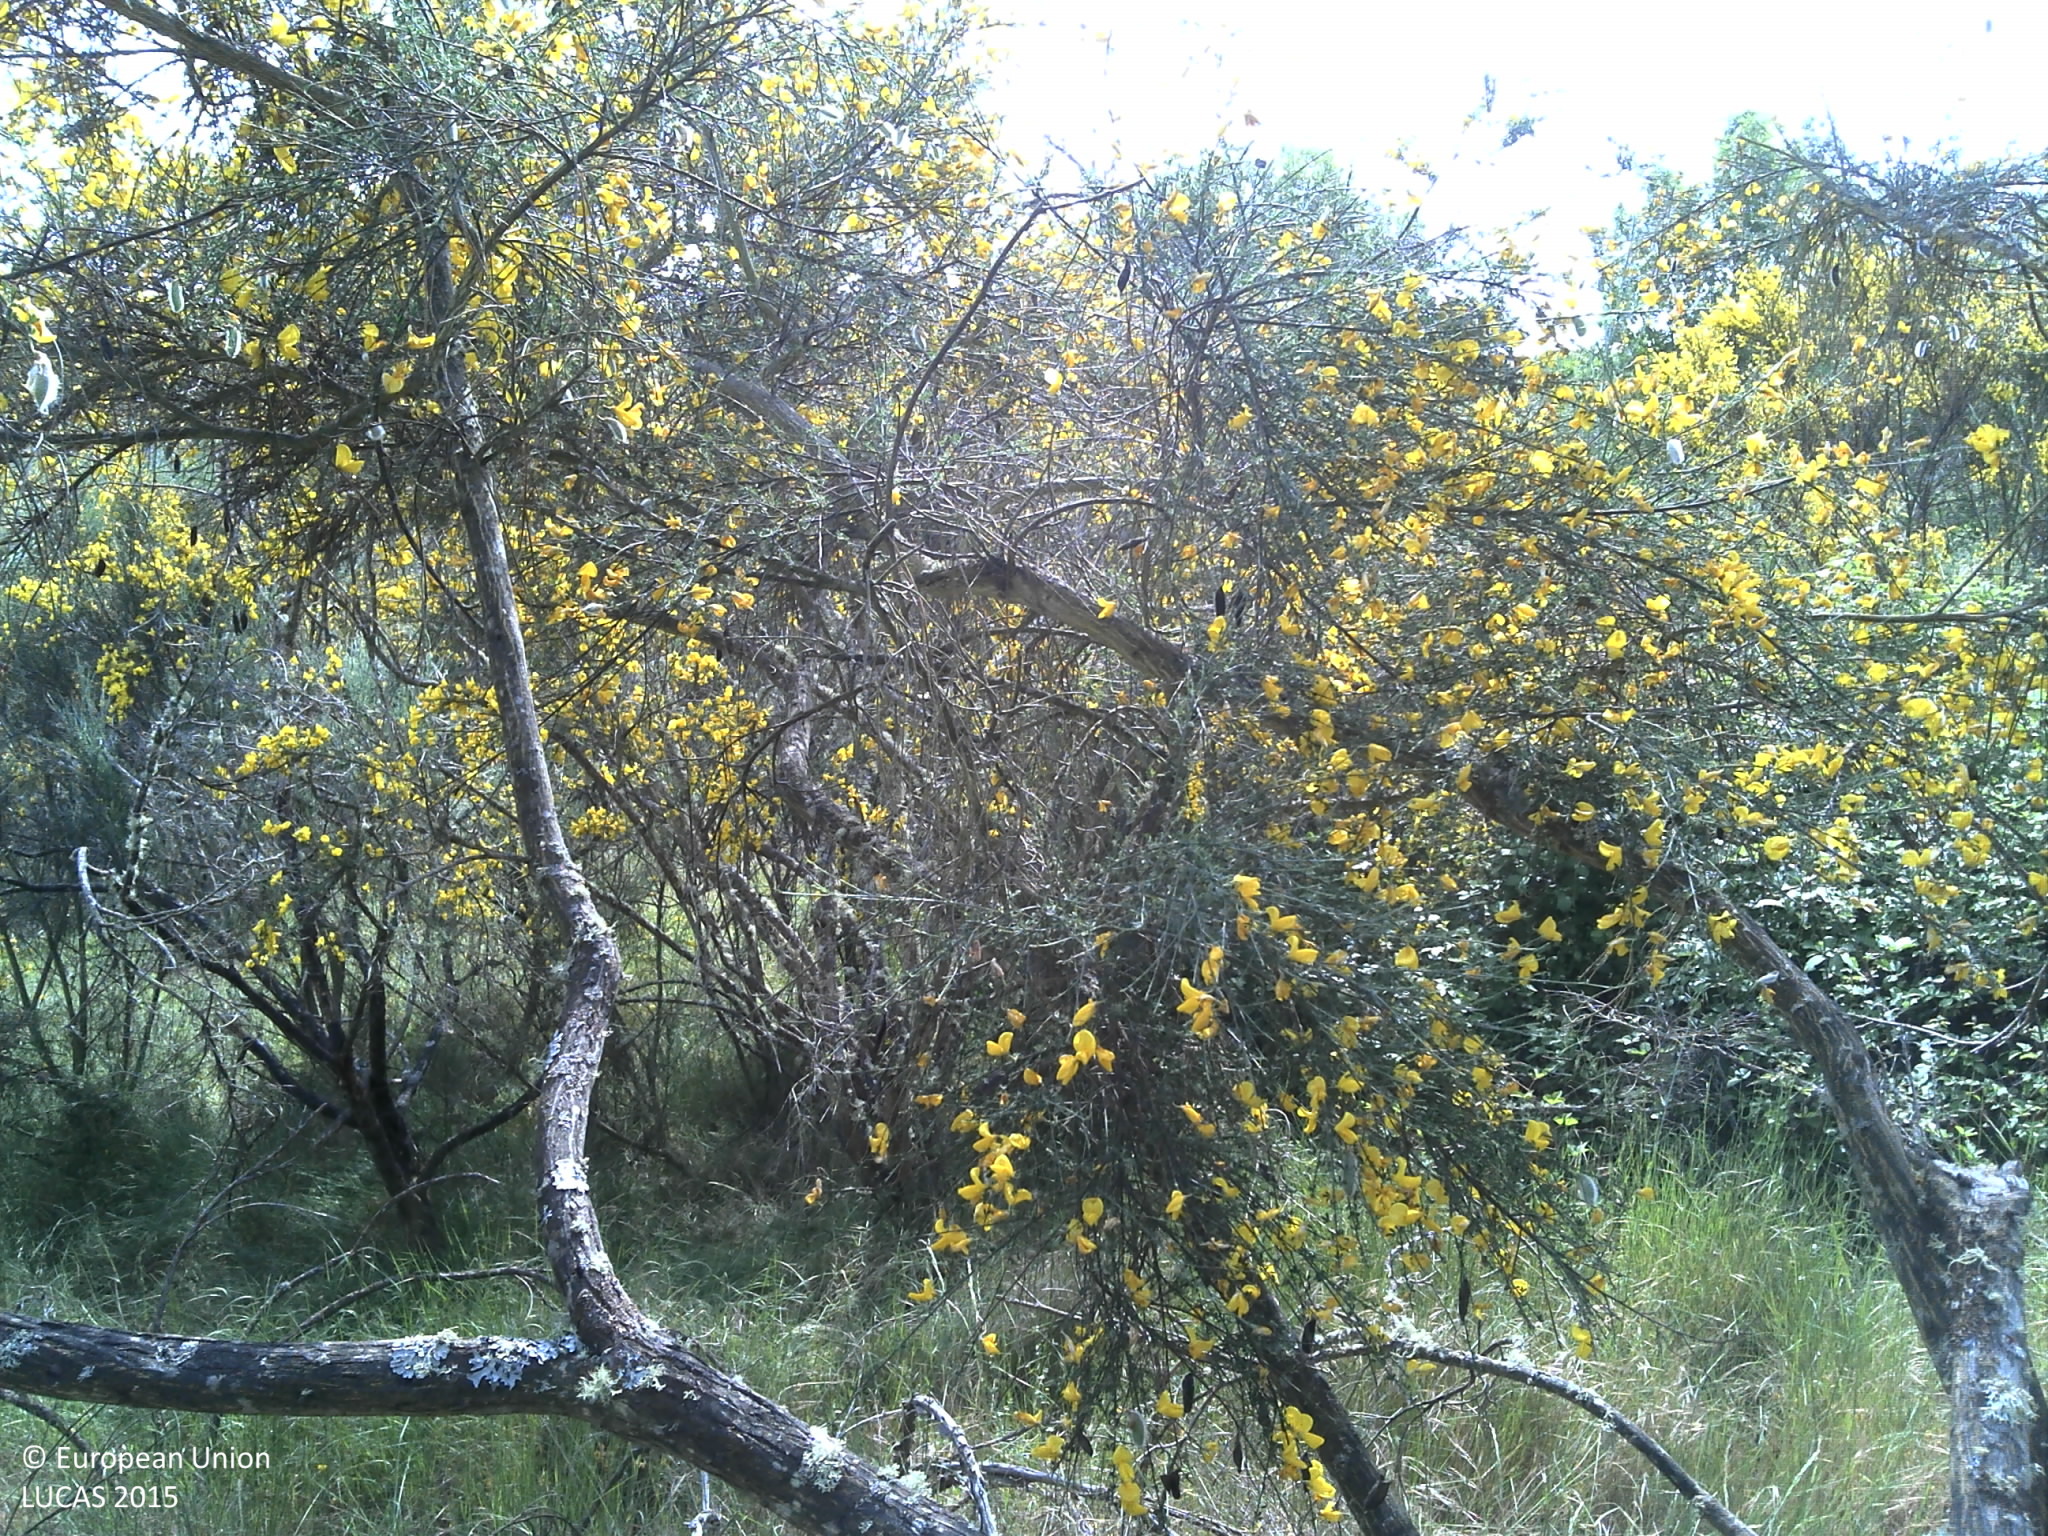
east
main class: Shrubland
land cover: Shrubland with sparse tree cover
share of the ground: > 75 %
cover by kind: shrubs 85 %, herbaceous plants 10 %, coniferous forest trees 5 %
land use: Forestry
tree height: > 5 m
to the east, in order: Shrubland with sparse tree cover; Spontaneously vegetated surfaces; Vineyards; Tracks; Vineyards; Tracks; Grass margins; Vineyards; Olive groves
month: May
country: PT
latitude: 41.5566
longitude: -7.3046
